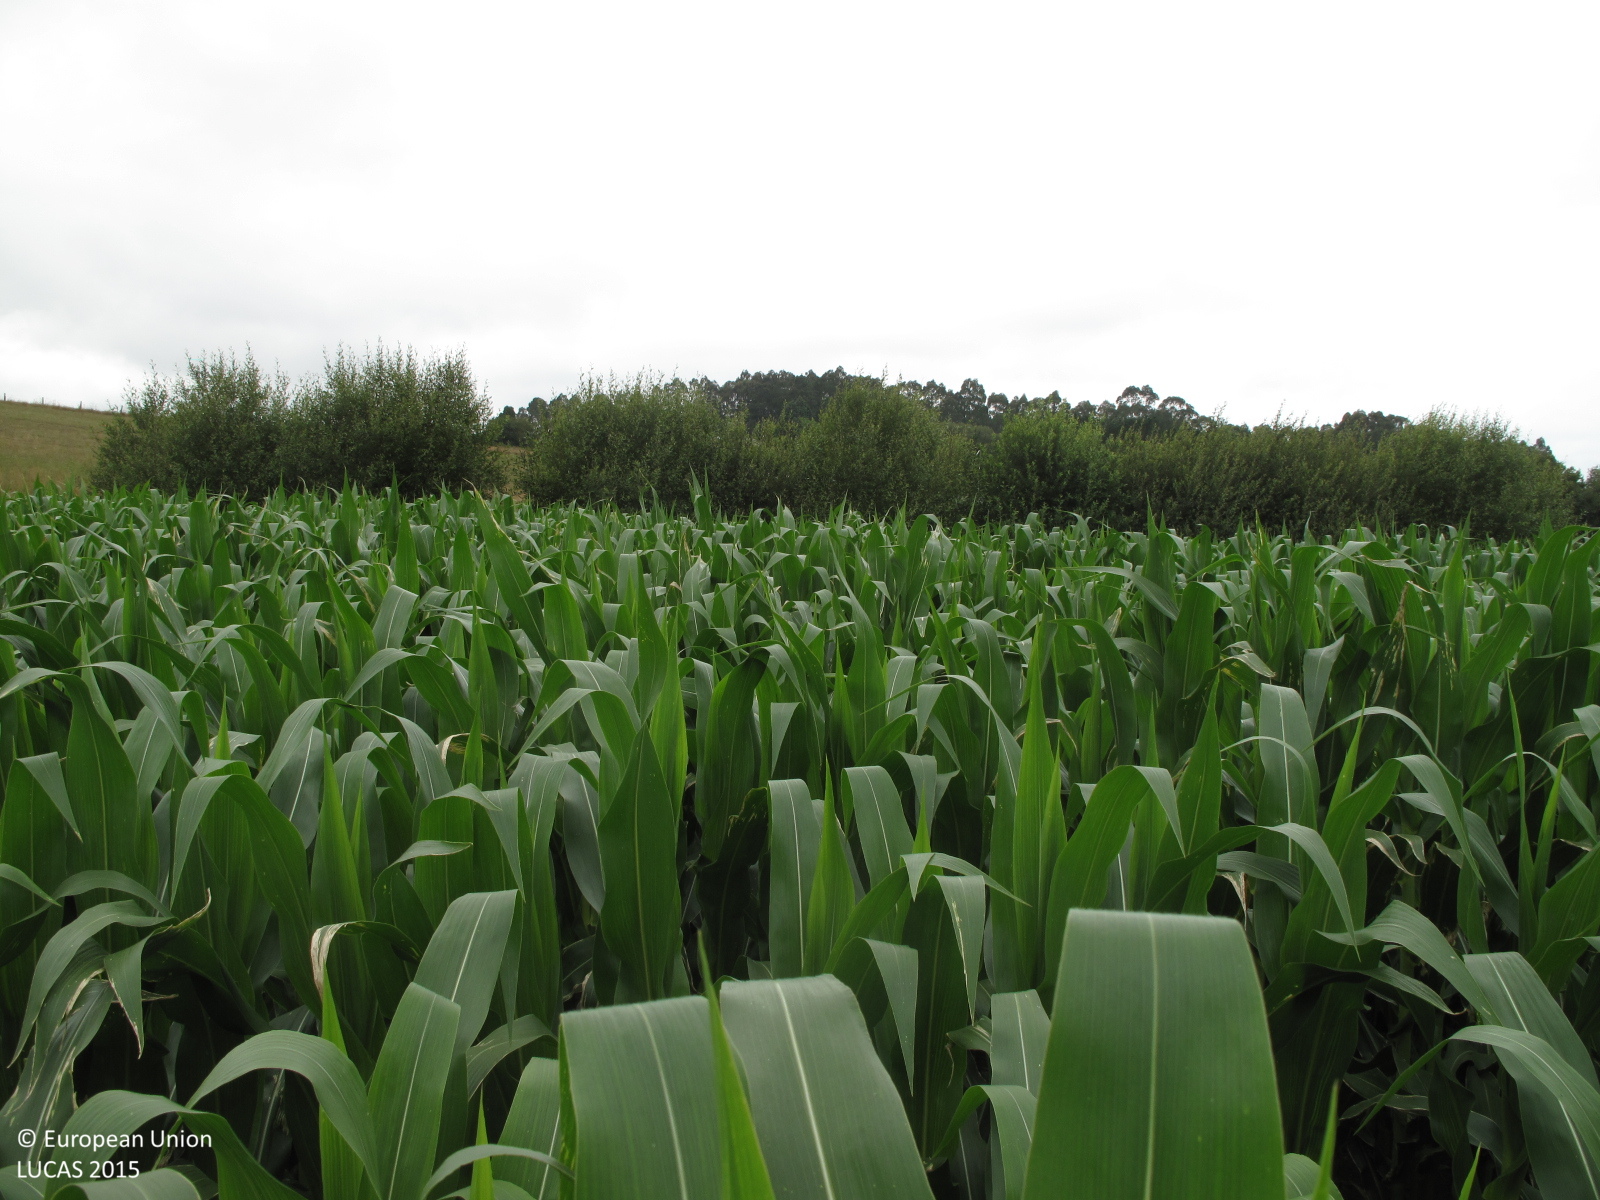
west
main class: Cropland
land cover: Maize
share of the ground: > 75 %
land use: Agriculture (excluding fallow land and kitchen gardens)
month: July
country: ES
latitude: 43.0989
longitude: -8.1695
